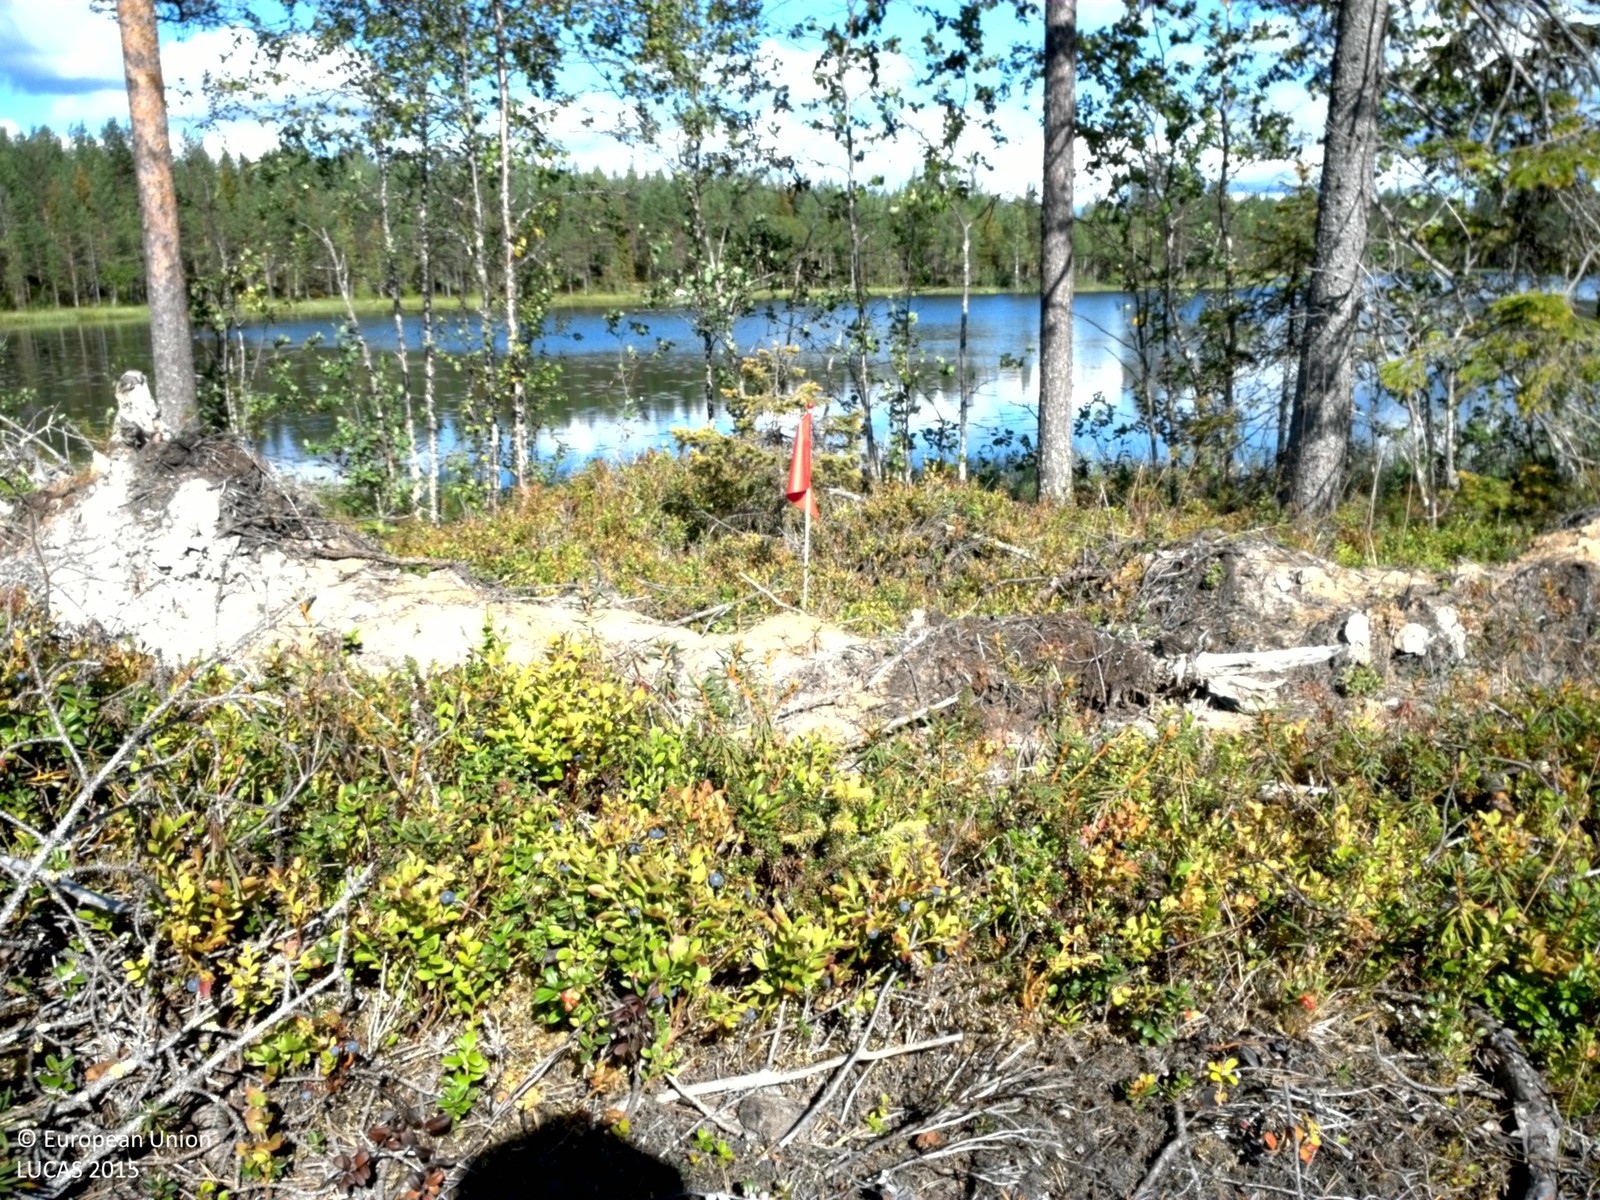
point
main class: Shrubland
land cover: Shrubland with sparse tree cover
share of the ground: > 75 %
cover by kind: shrubs 80 %, unconsolidated bare surface 15 %, coniferous forest trees 5 %
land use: Forestry
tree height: < 5 m
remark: Clear cut
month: August
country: SE
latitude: 66.0781
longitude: 22.5979
